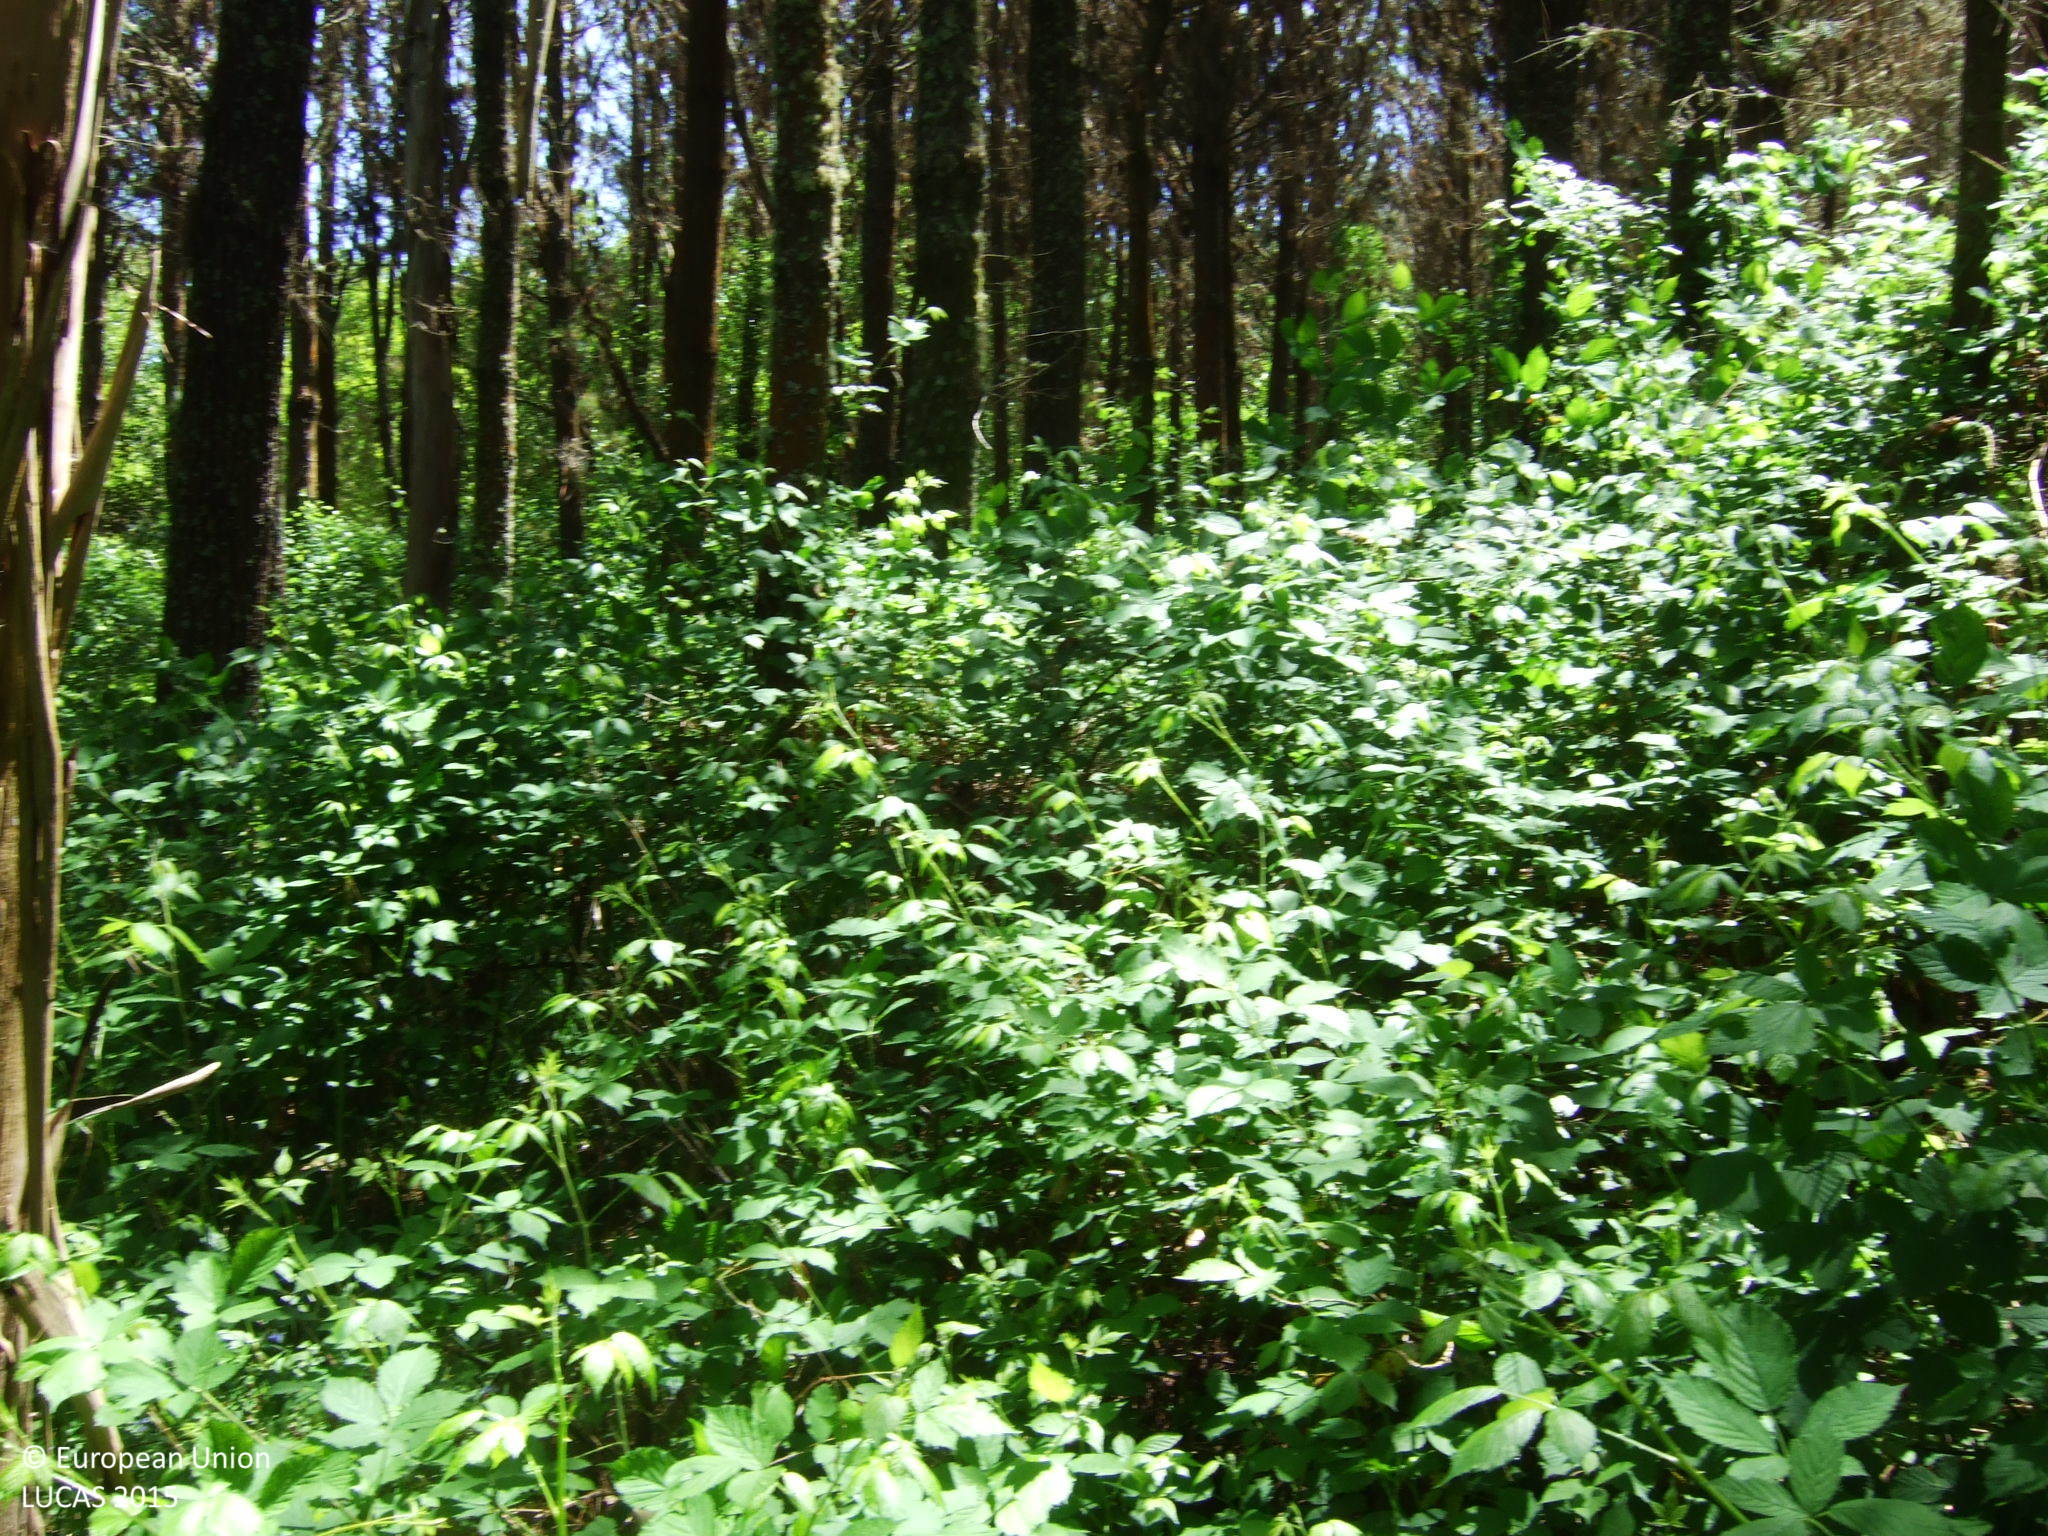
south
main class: Woodland
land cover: Pine dominated mixed woodland
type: exotic forest
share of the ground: 50 - 75 %
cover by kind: coniferous forest trees 40 %, broadleaved forest trees 30 %, shrubs 30 %
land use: Forestry
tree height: > 5 m
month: May
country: ES
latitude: 43.2629
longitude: -7.6631
